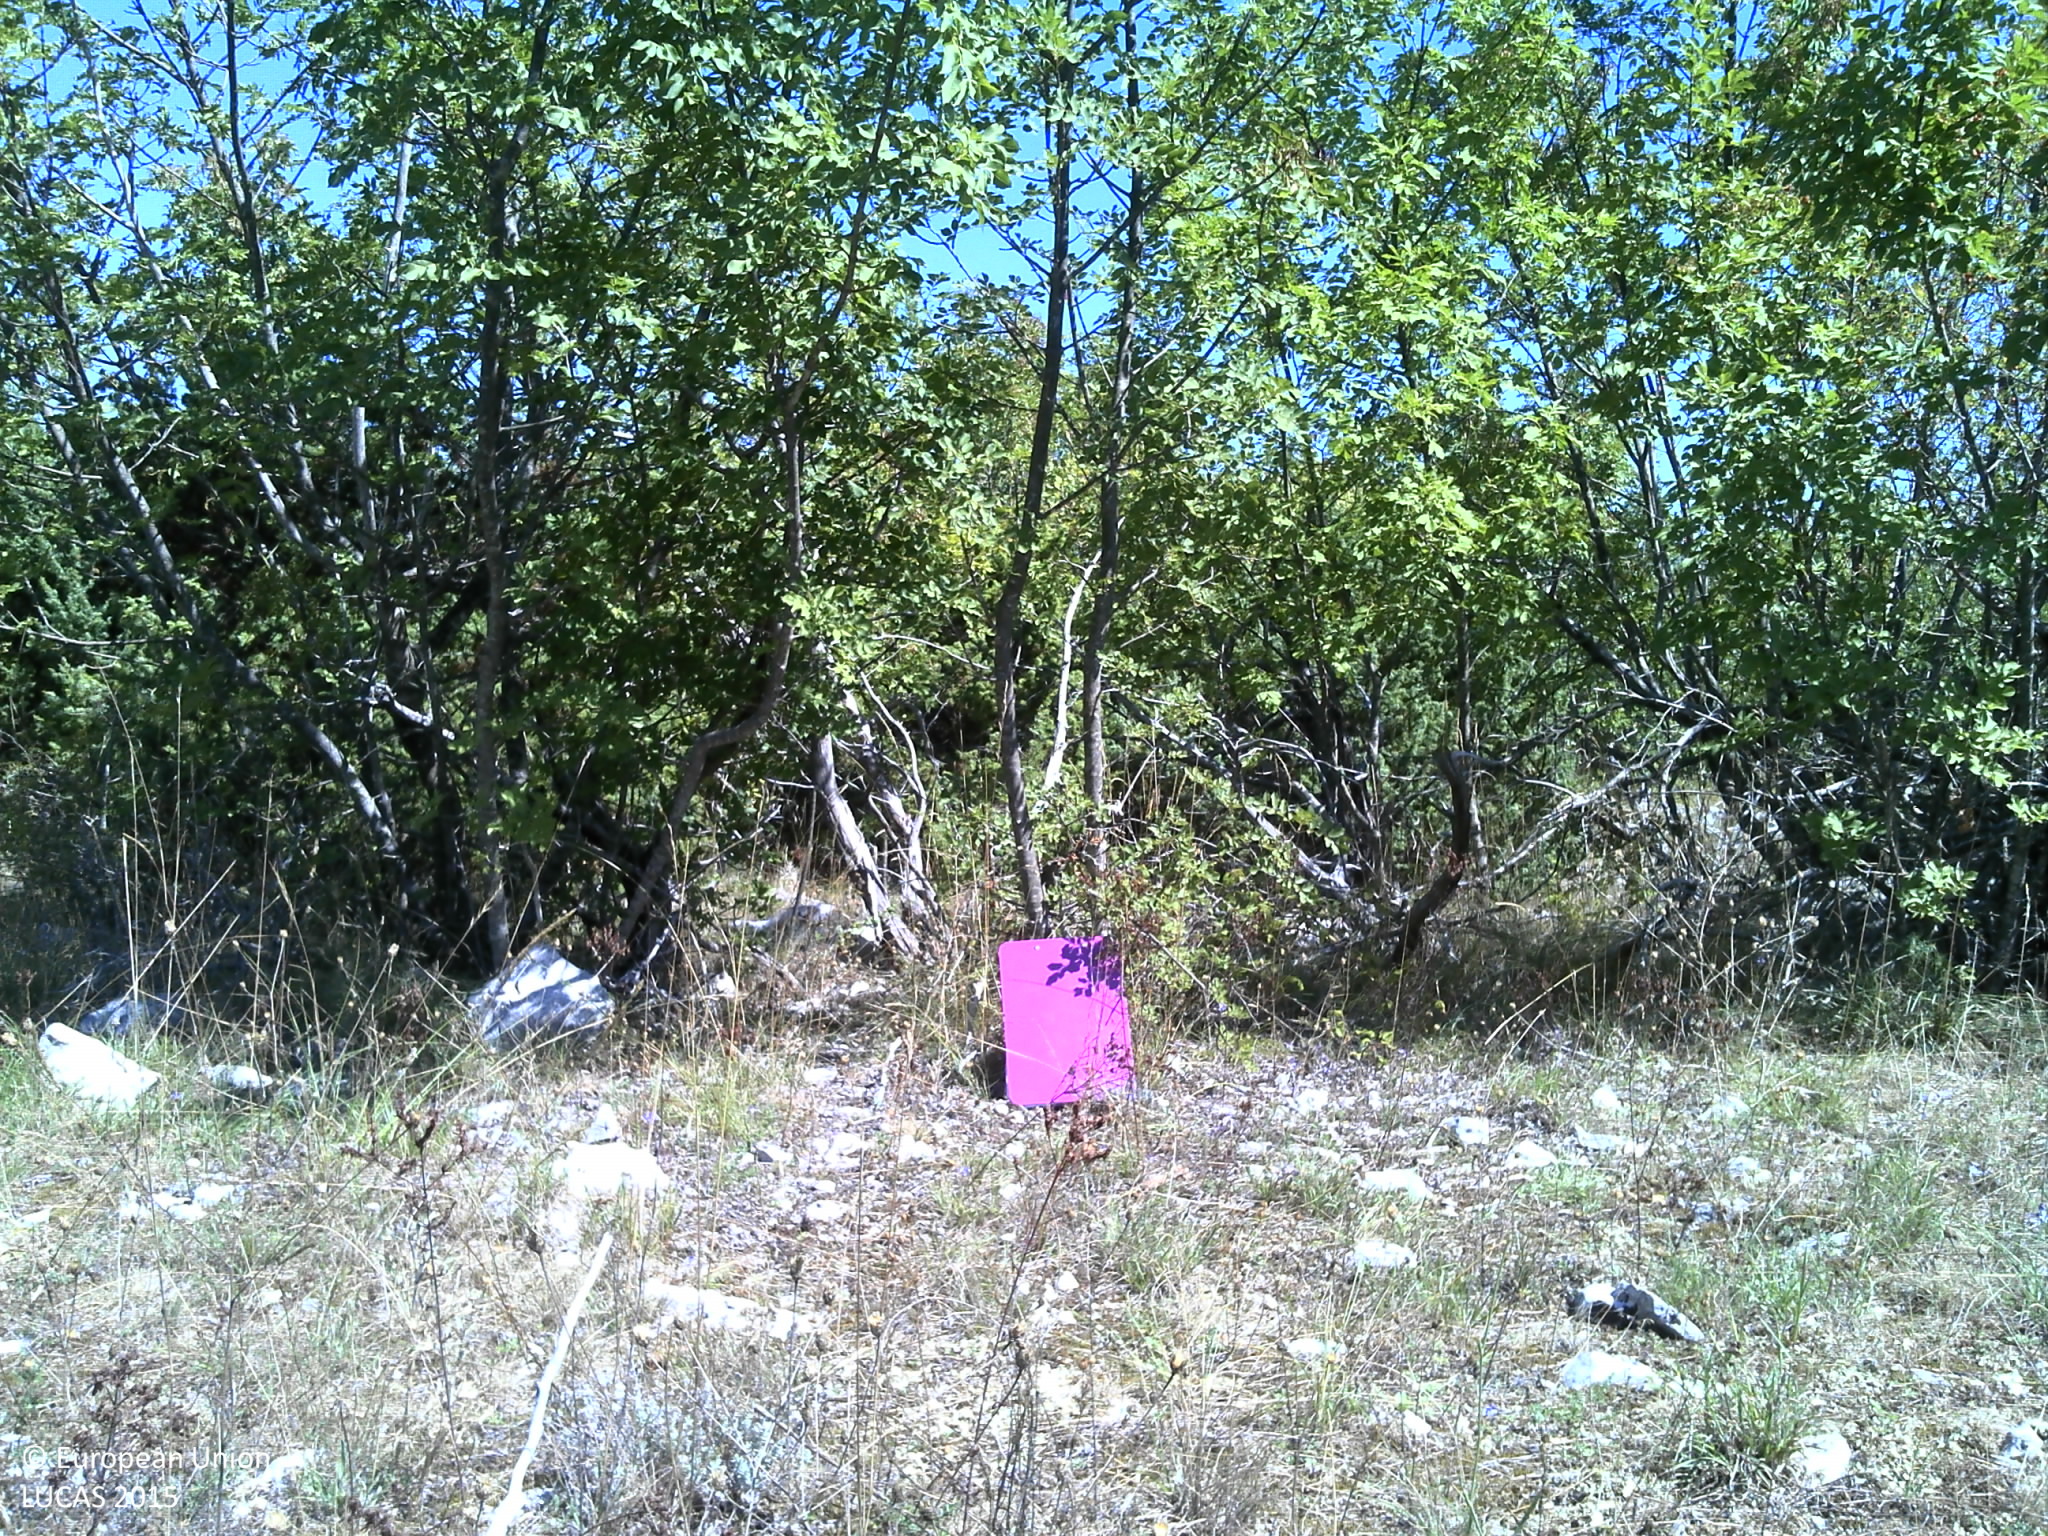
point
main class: Shrubland
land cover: Shrubland with sparse tree cover
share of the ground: 25 - 50 %
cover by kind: herbaceous plants 40 %, shrubs 35 %, consolidated bare surface 10 %, unconsolidated bare surface 10 %, broadleaved forest trees 5 %
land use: Semi-natural and natural areas not in use
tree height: < 5 m
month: September
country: HR
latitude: 43.5820
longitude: 16.2697
